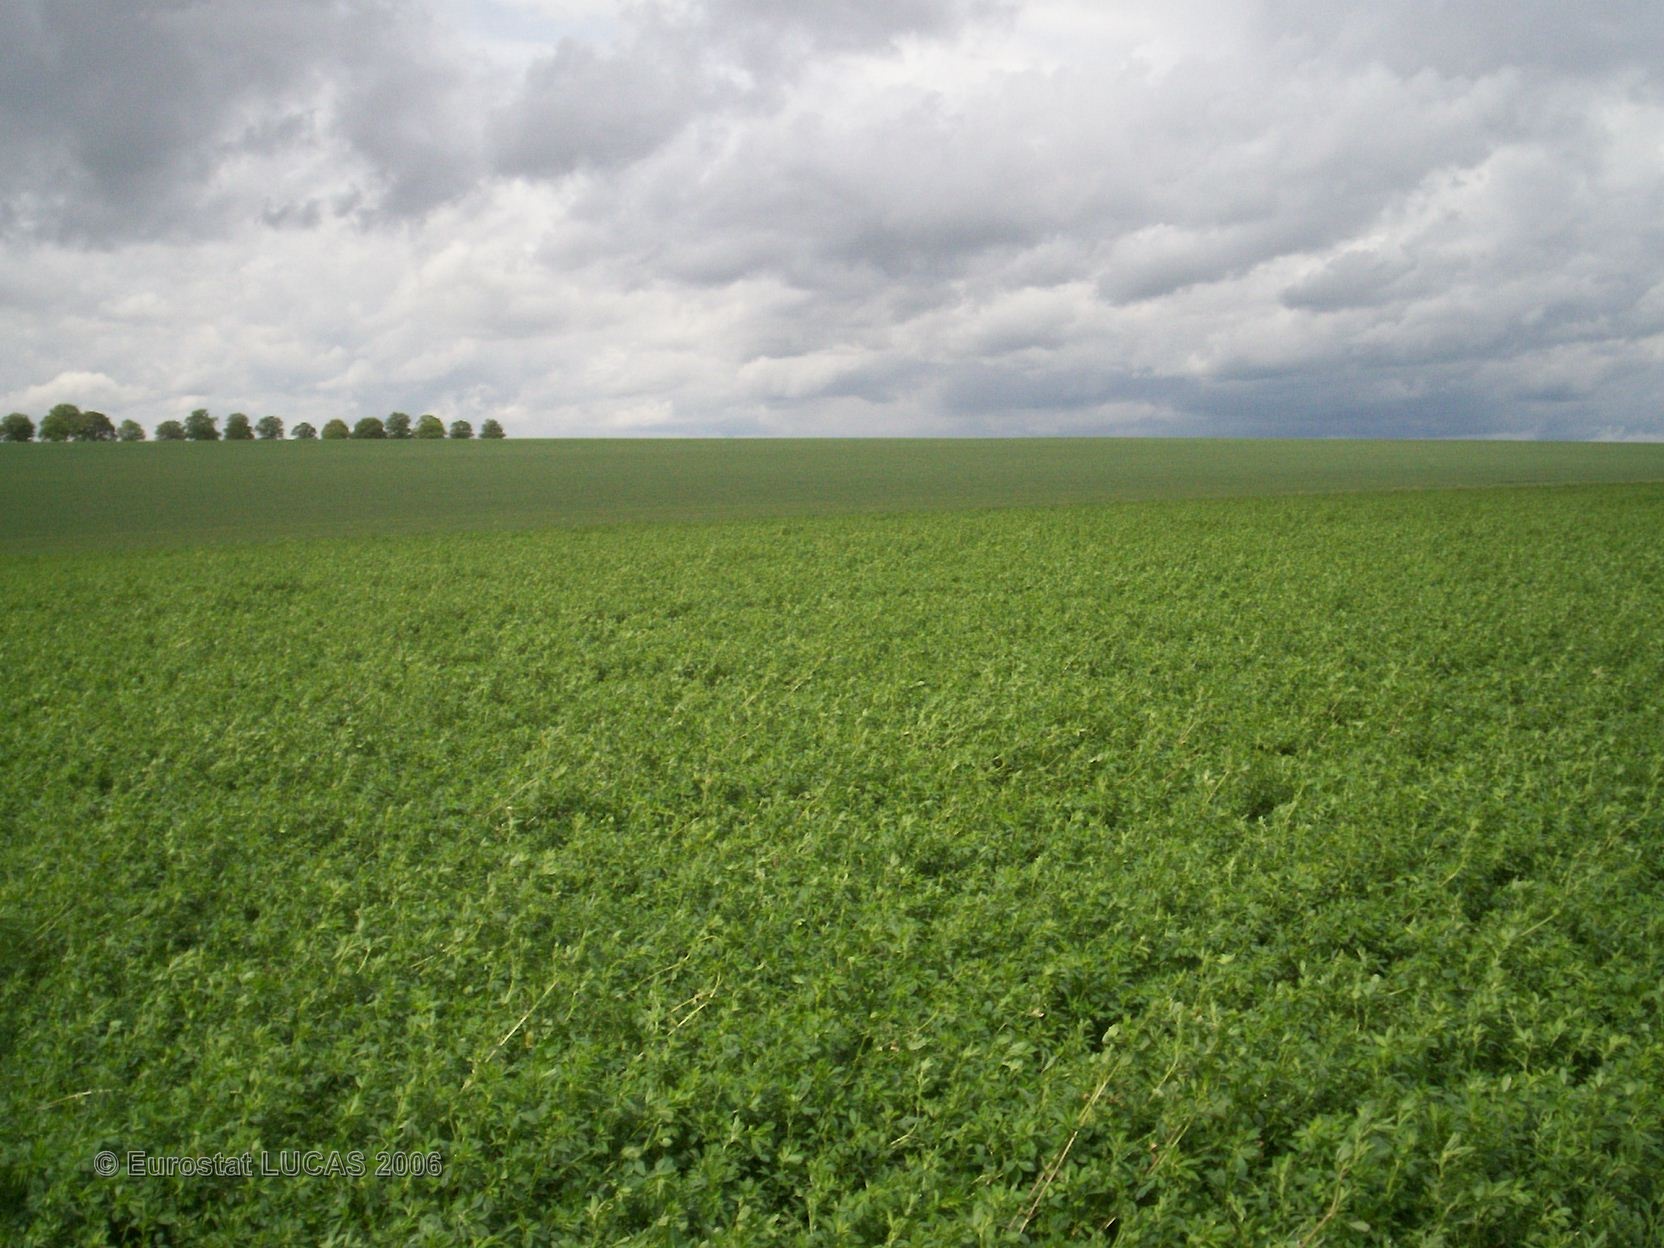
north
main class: Cropland
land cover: Lucerne
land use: Agriculture (excluding fallow land and kitchen gardens)
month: May
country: FR
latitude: 49.4660
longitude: 4.3246
